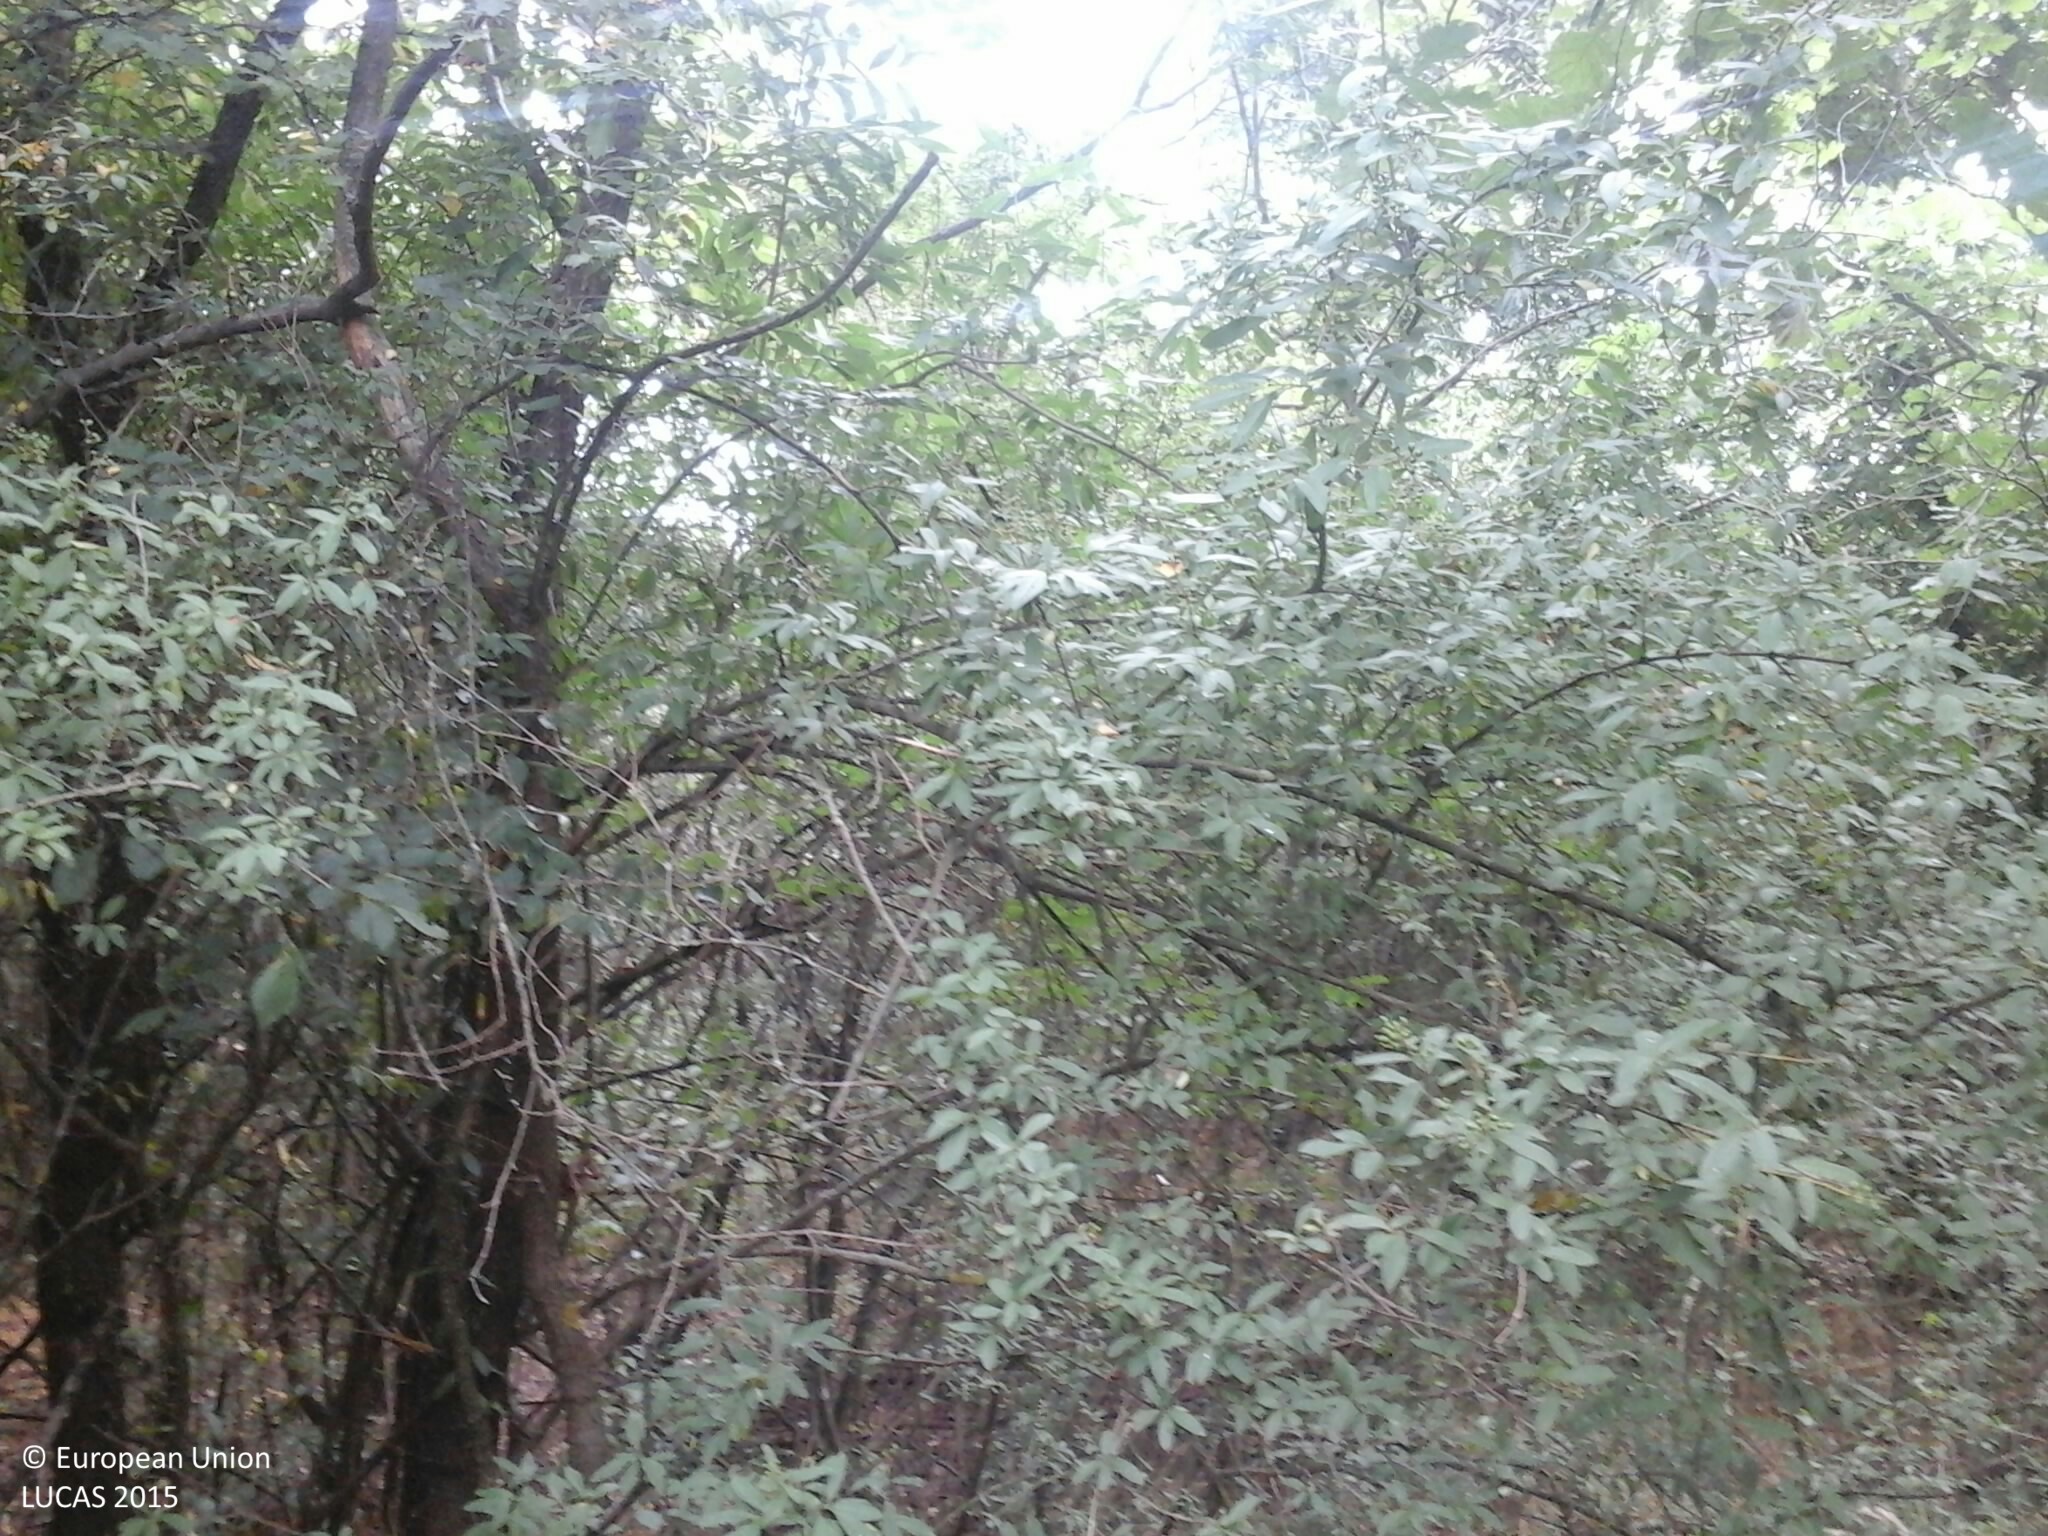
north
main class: Woodland
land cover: Broadleaved woodland
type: mesophytic deciduous forest
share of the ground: > 75 %
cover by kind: broadleaved forest trees 95 %, herbaceous plants 5 %
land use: Forestry
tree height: < 5 m
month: July
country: HU
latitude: 47.1358
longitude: 17.2441
